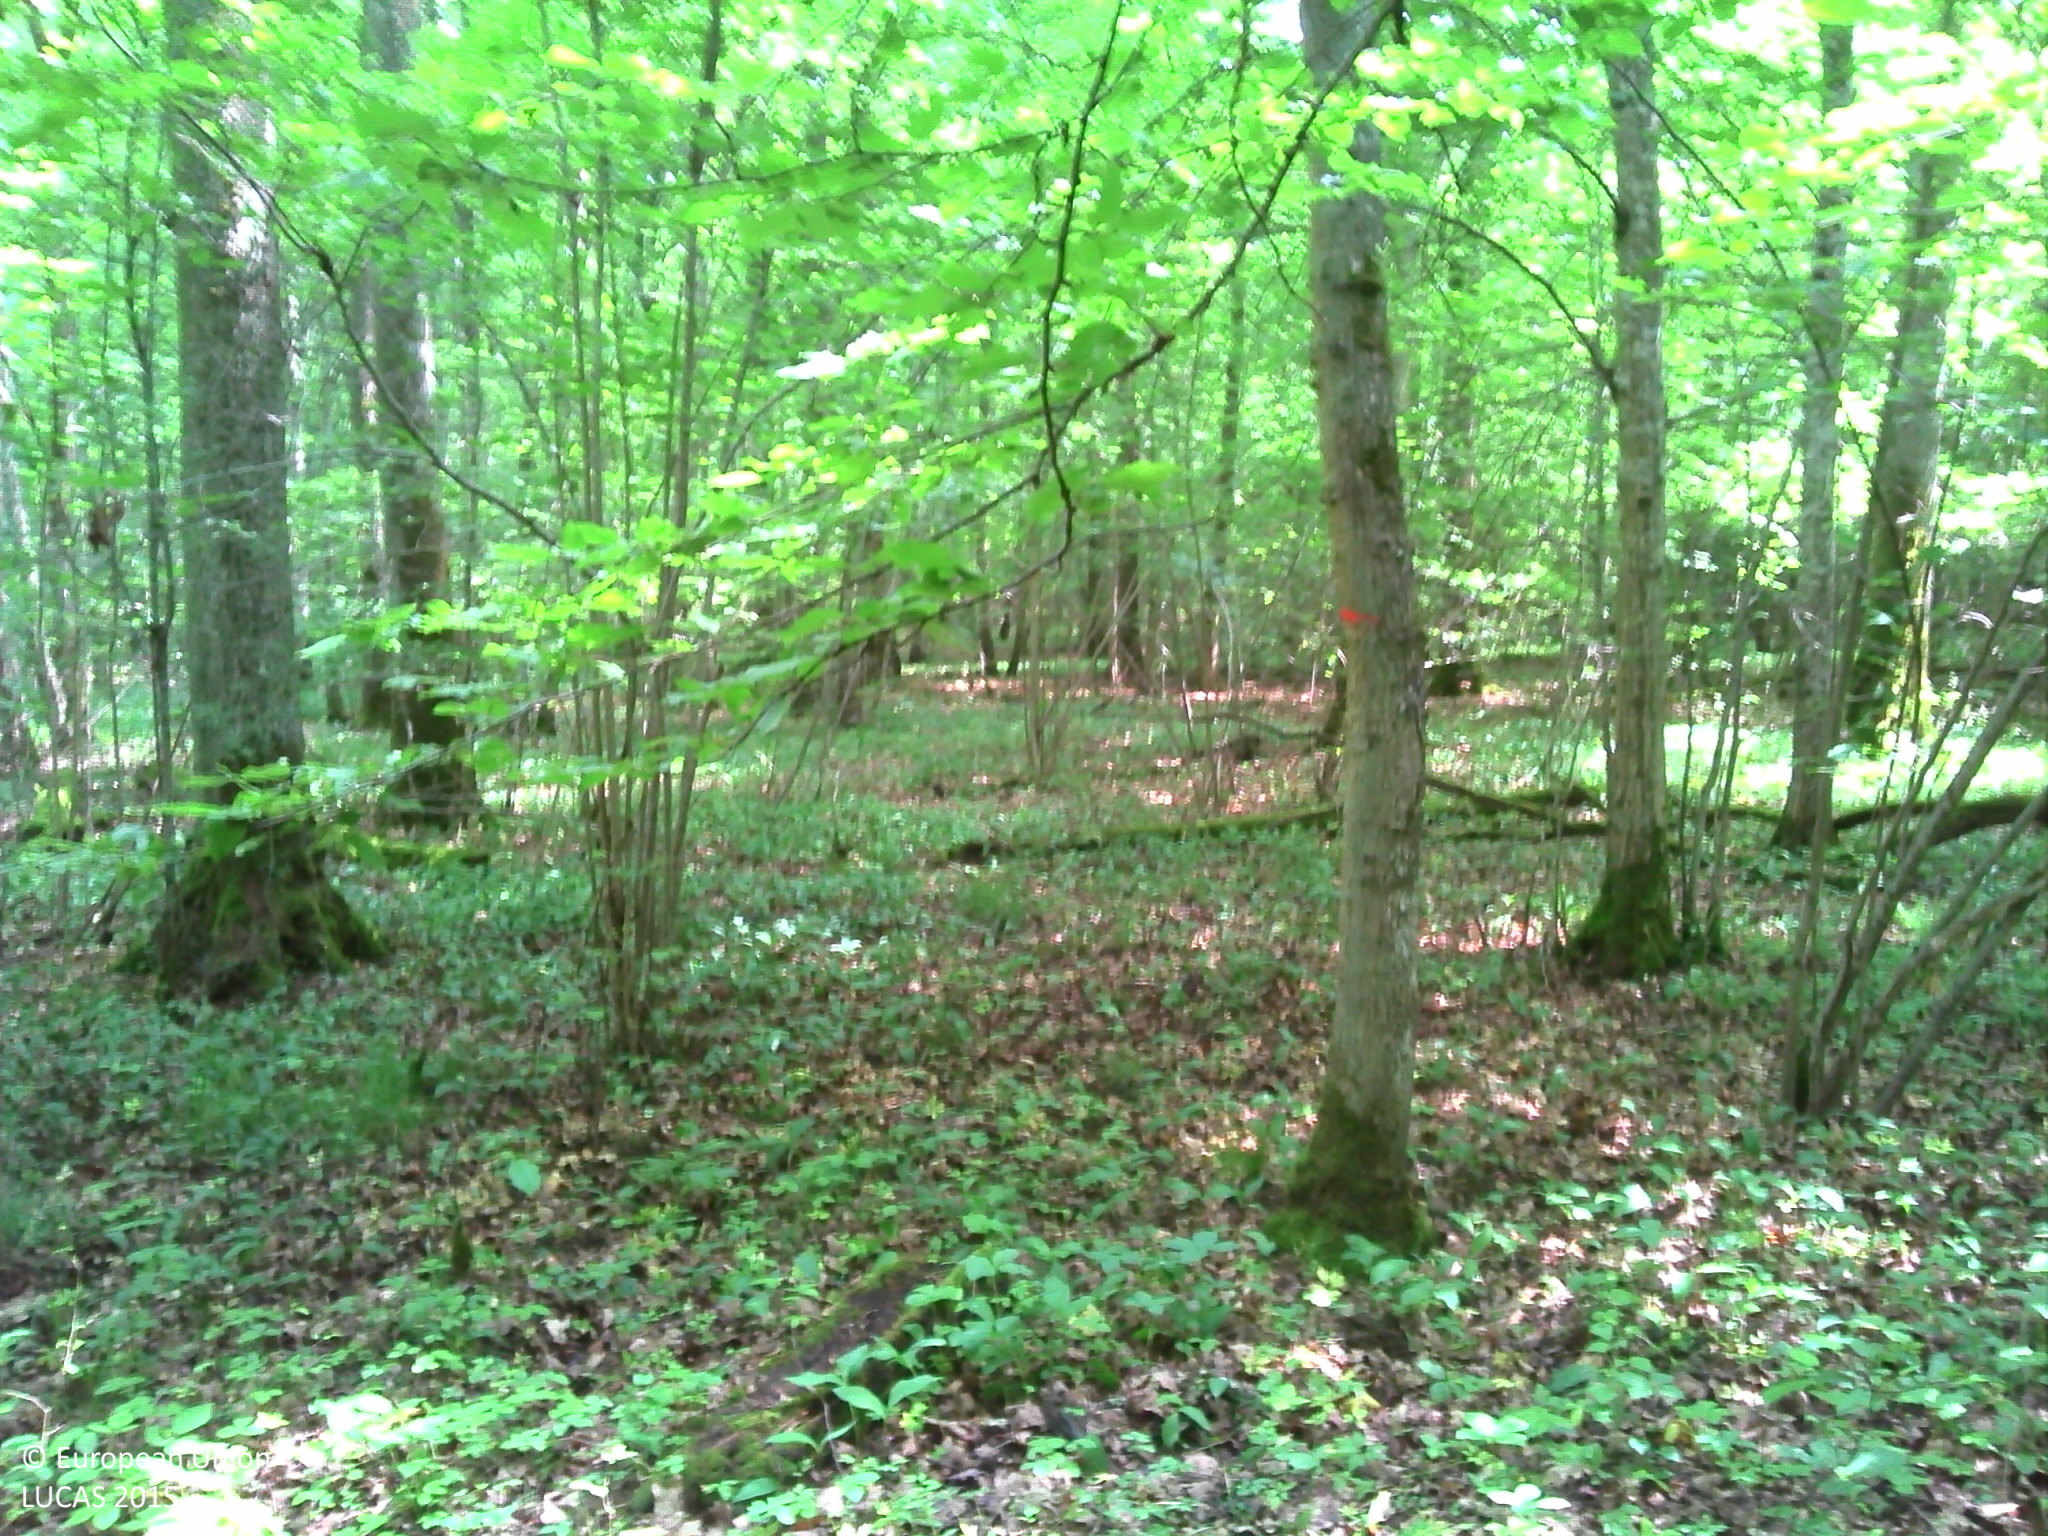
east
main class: Woodland
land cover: Broadleaved woodland
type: mesophytic deciduous forest
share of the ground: > 75 %
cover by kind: broadleaved forest trees 90 %, lichens and mosses 10 %
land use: Forestry
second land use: Amenities, museums, leisure
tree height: > 5 m
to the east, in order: Broadleaved woodland; Ditches and canals; Broadleaved woodland
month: June
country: FR
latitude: 48.7251
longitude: 5.9351
